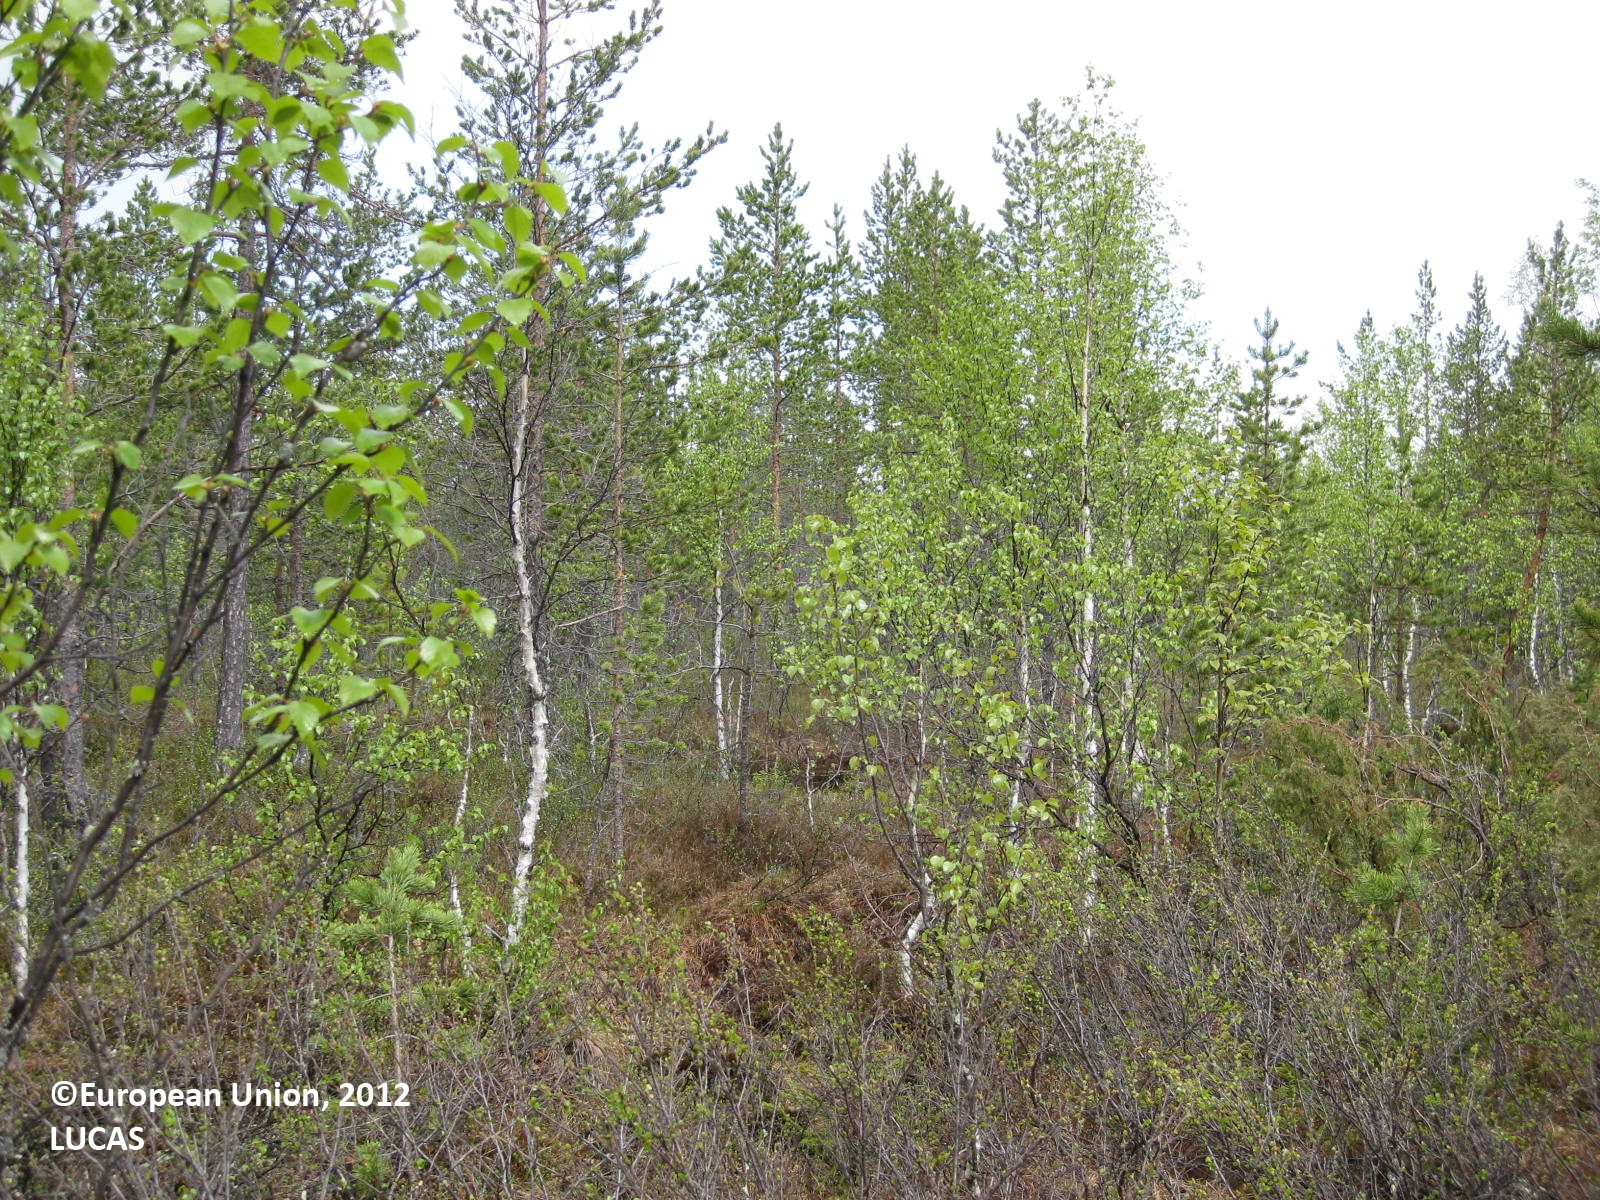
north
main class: Woodland
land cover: Pine dominated mixed woodland
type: boreal forest
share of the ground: 25 - 50 %
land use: Forestry
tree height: > 5 m
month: June
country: FI
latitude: 65.2089
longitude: 29.6815
